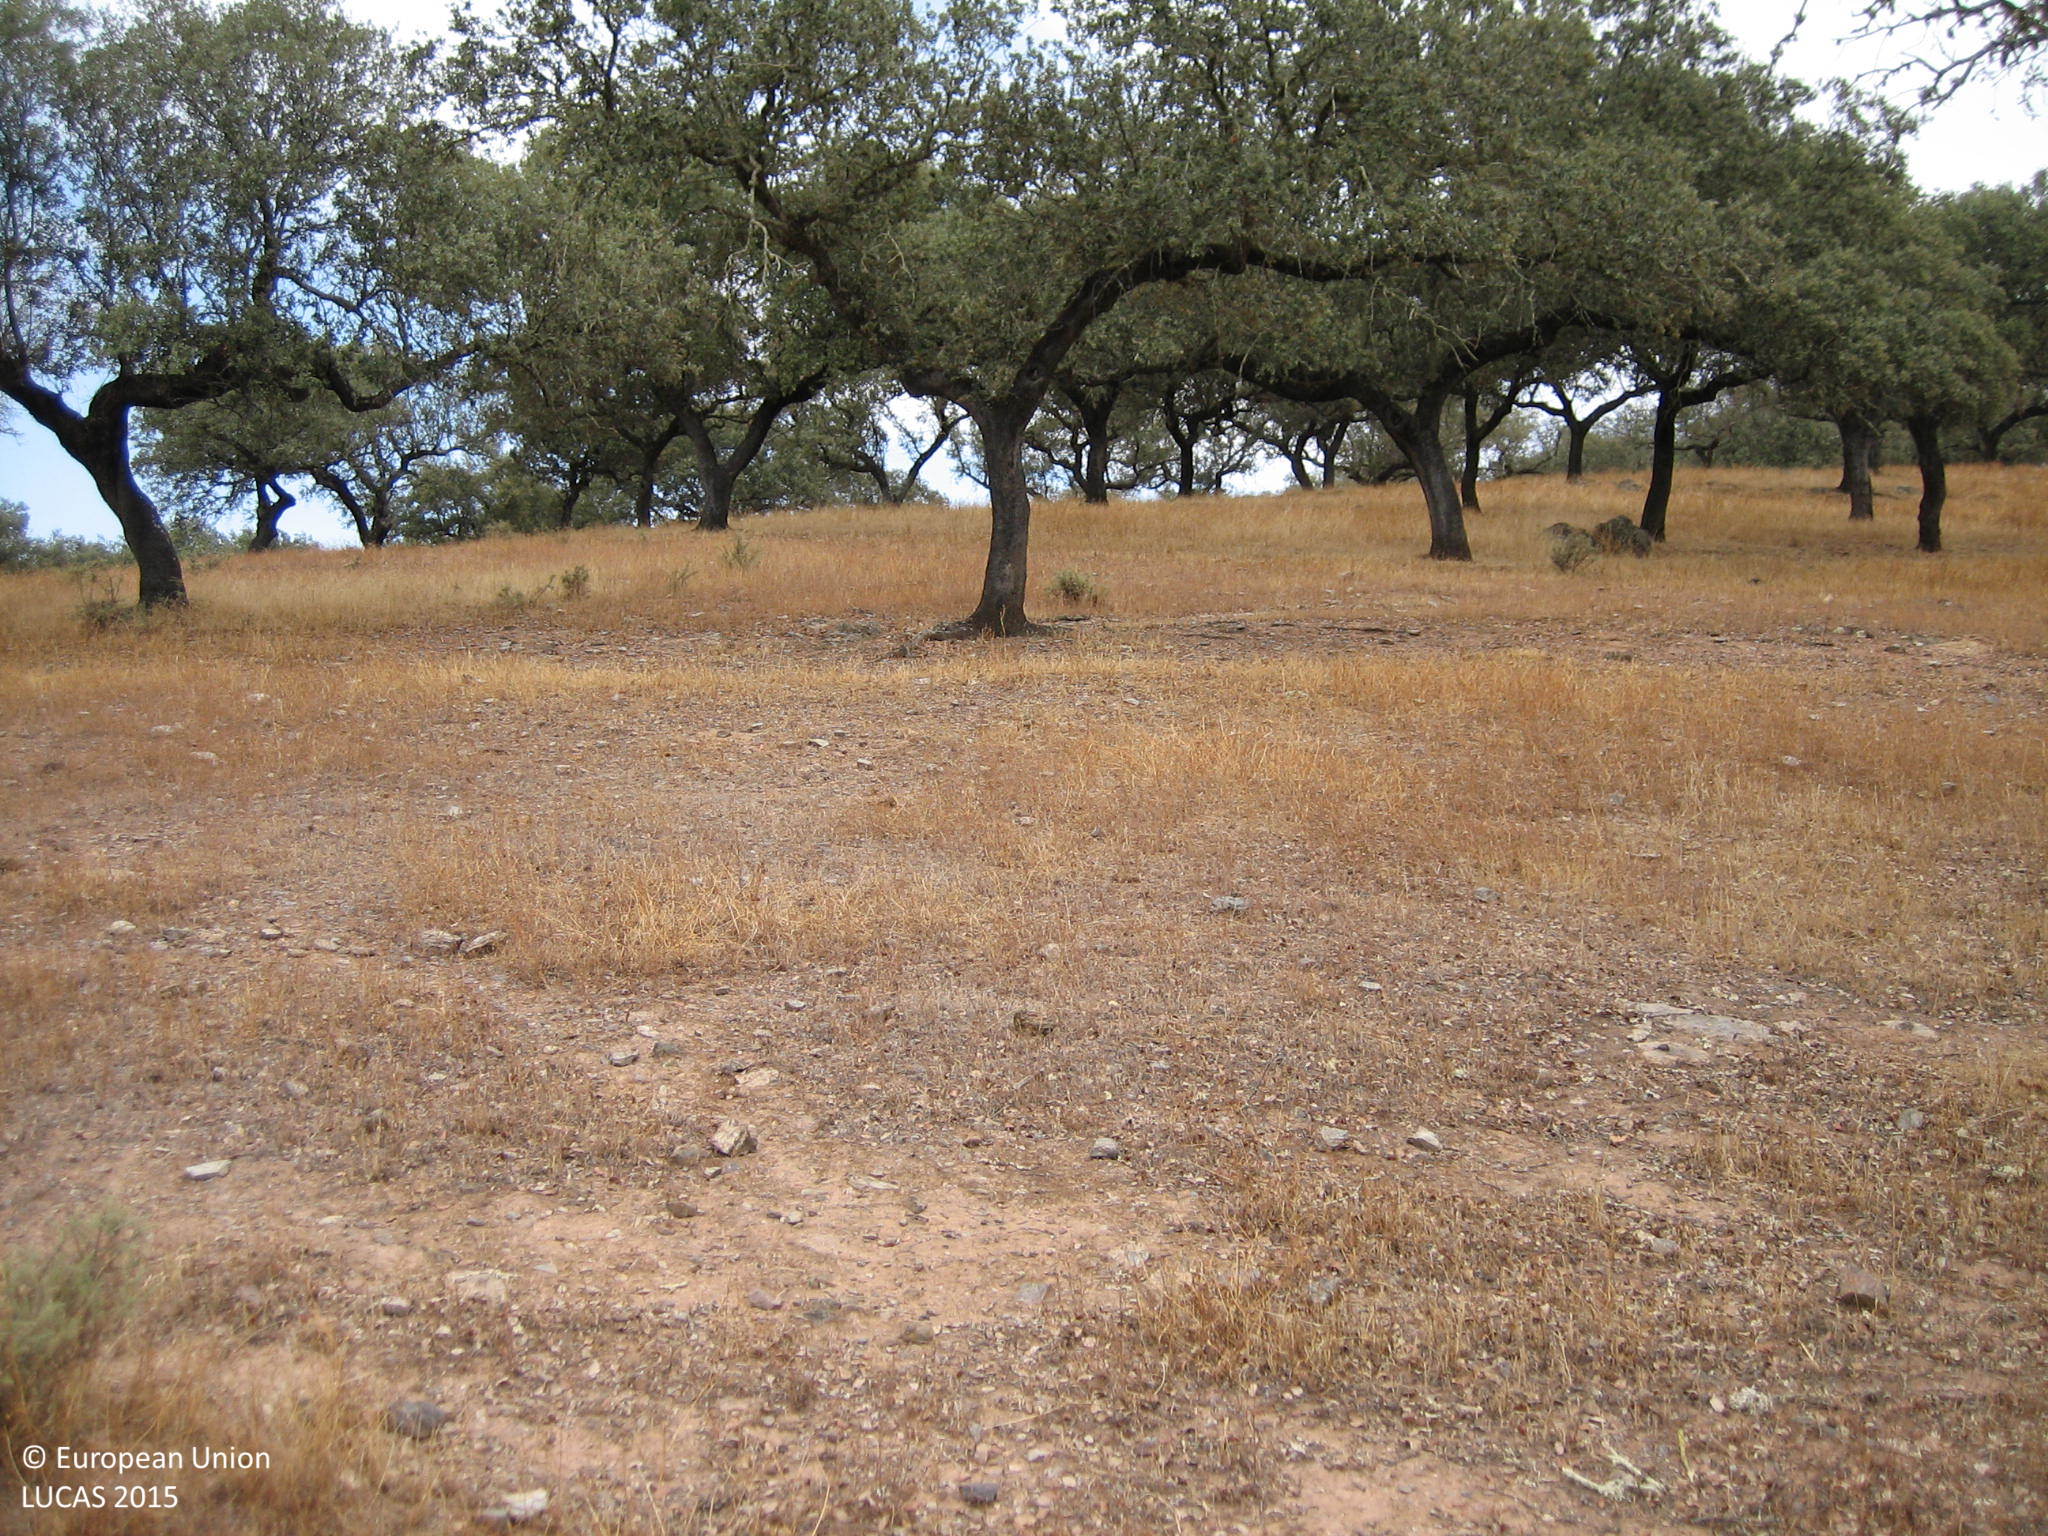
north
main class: Woodland
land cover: Broadleaved woodland
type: broadleaved evergreen forest
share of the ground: 25 - 50 %
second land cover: Grassland without tree/shrub cover
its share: > 75 %
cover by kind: herbaceous plants 60 %, broadleaved forest trees 40 %
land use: Forestry
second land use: Agriculture (excluding fallow land and kitchen gardens)
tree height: > 5 m
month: September
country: ES
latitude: 38.2552
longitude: -7.0997
